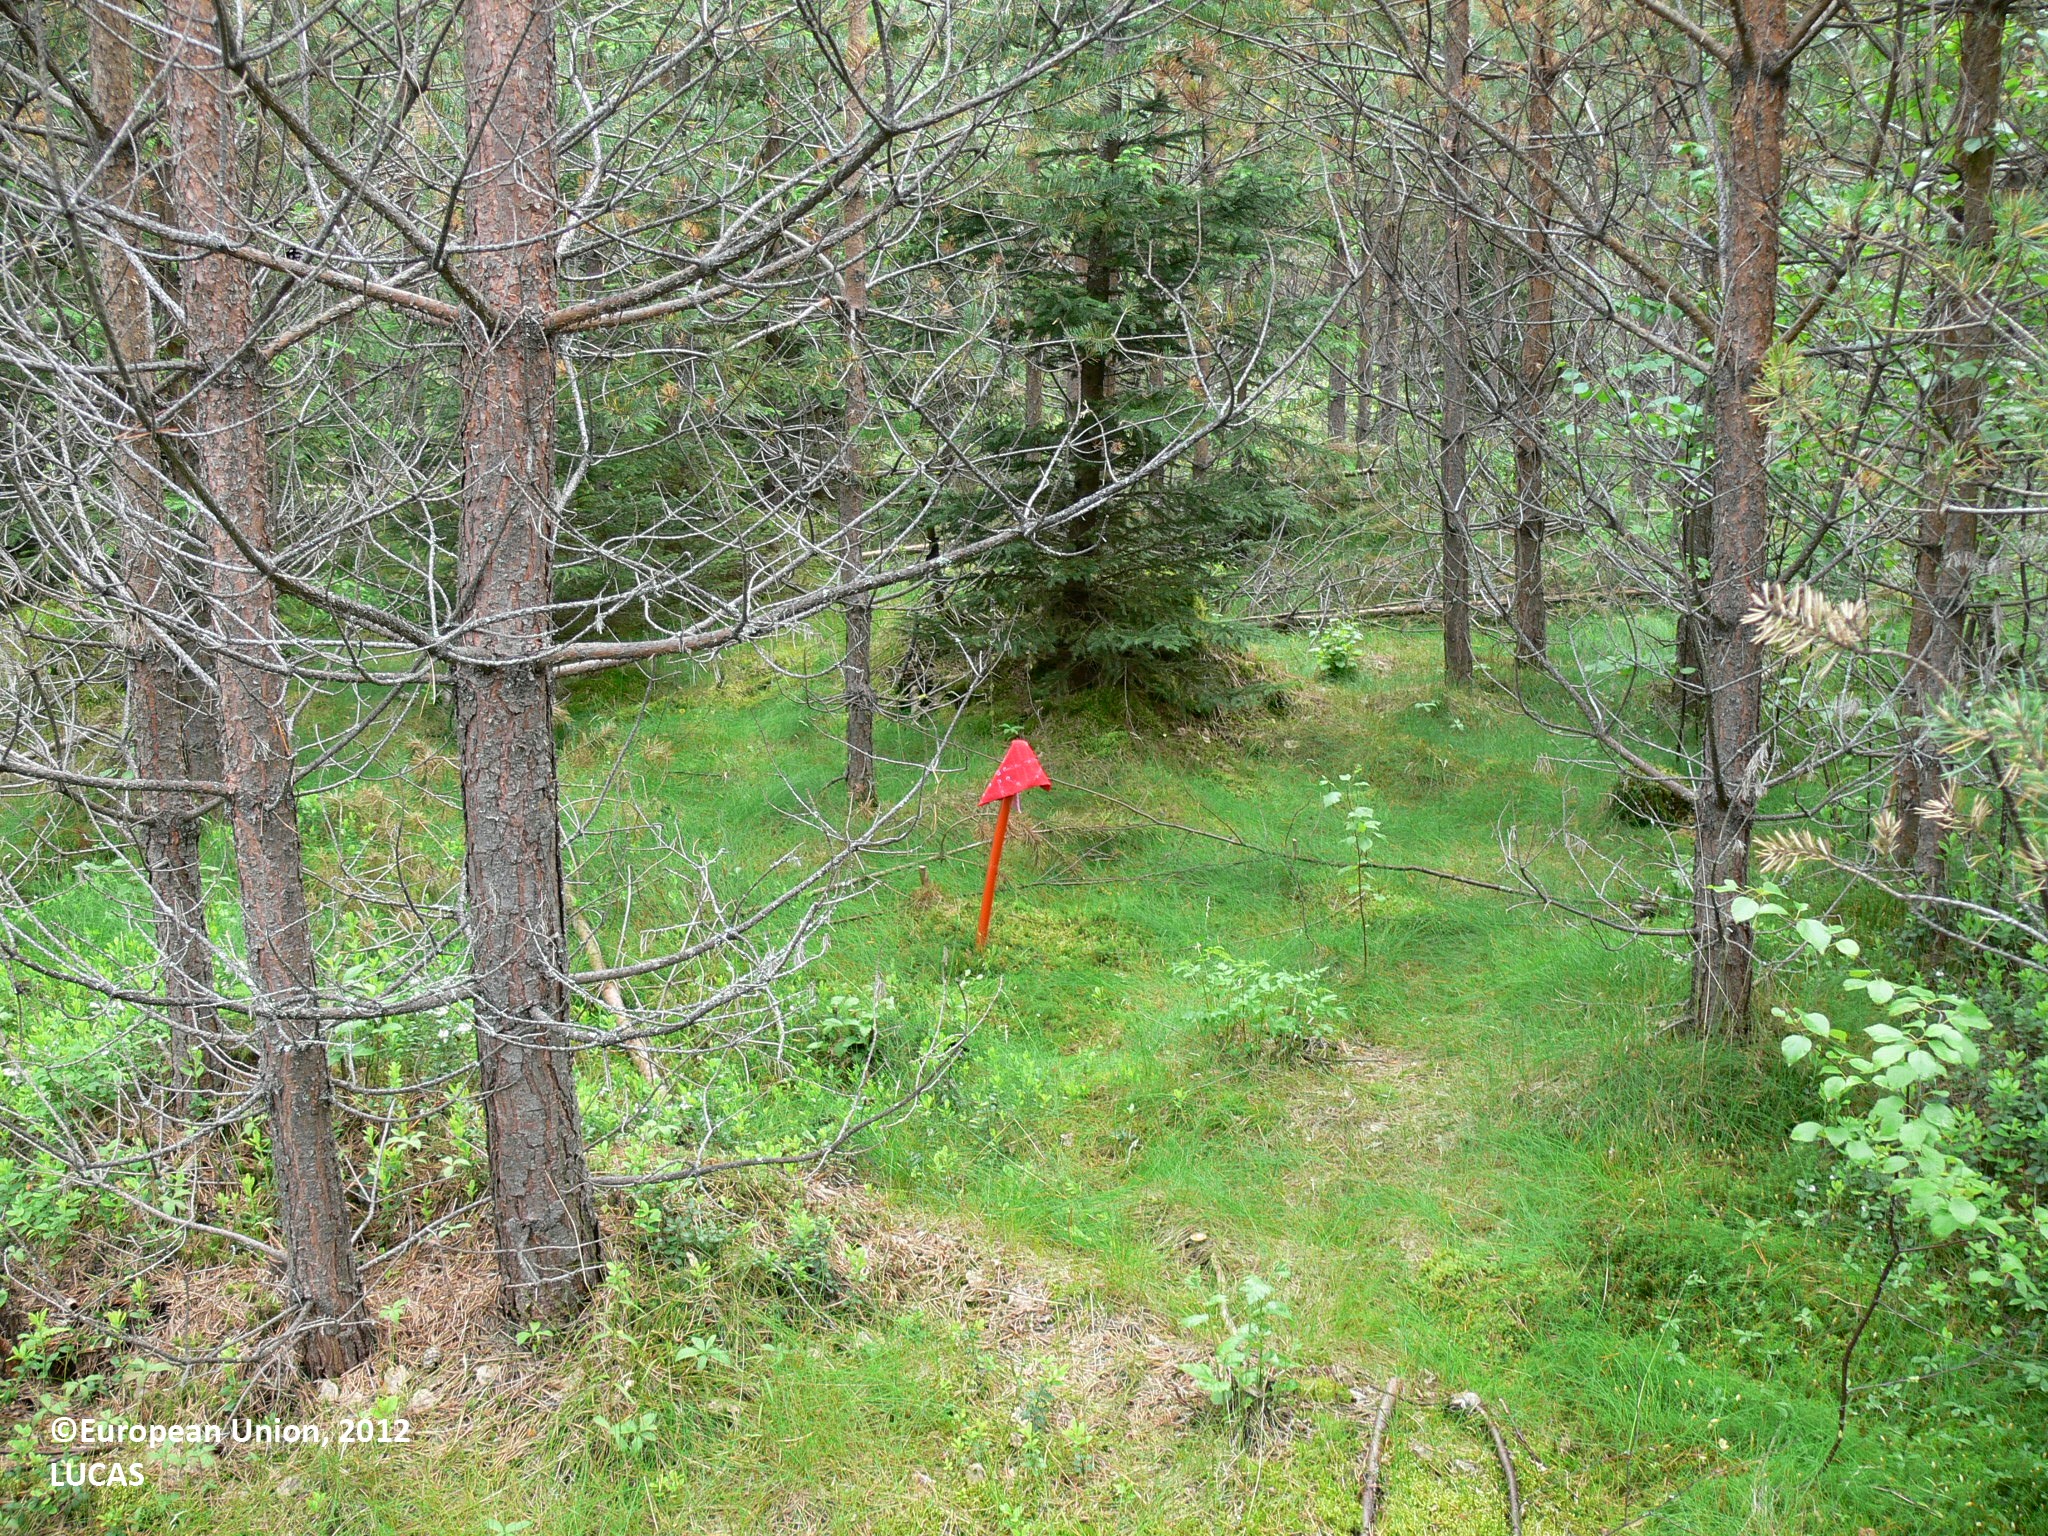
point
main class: Woodland
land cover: Other coniferous woodland
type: boreal forest
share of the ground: > 75 %
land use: Forestry
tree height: < 5 m
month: June
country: FI
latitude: 62.5486
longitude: 29.5085
